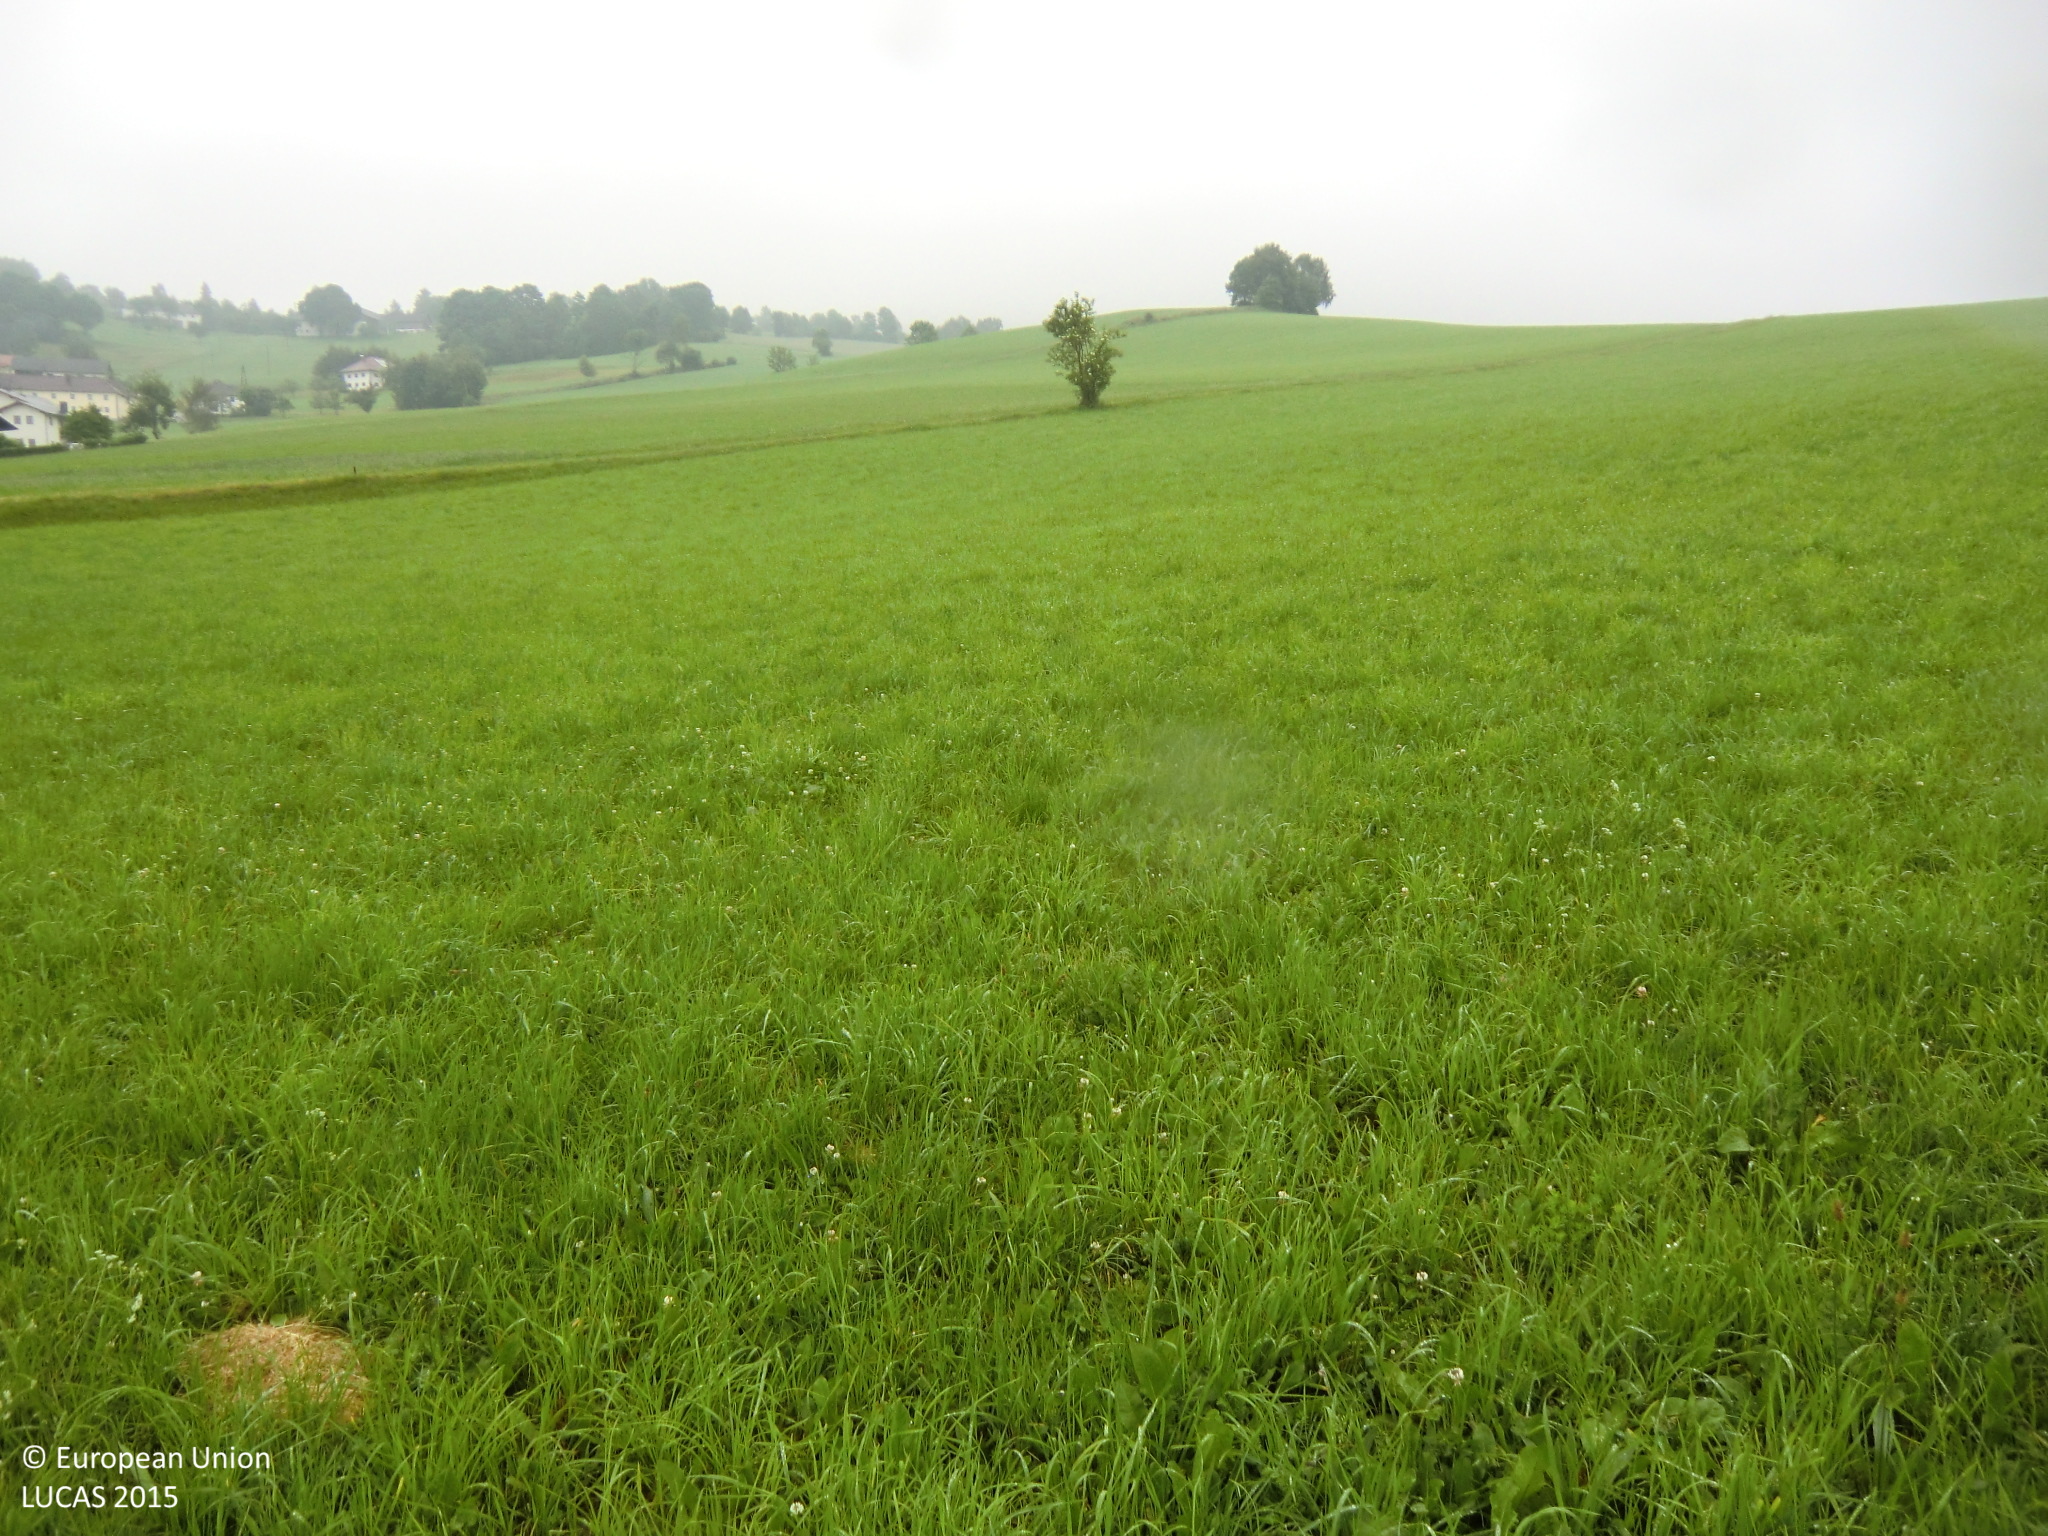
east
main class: Grassland
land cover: Grassland without tree/shrub cover
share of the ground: > 75 %
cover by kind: herbaceous plants 100 %
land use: Agriculture (excluding fallow land and kitchen gardens)
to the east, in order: Grassland without tree/shrub cover; Tracks; Temporary grasslands; Grassland without tree/shrub cover
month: June
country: AT
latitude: 48.5974
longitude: 14.5705
